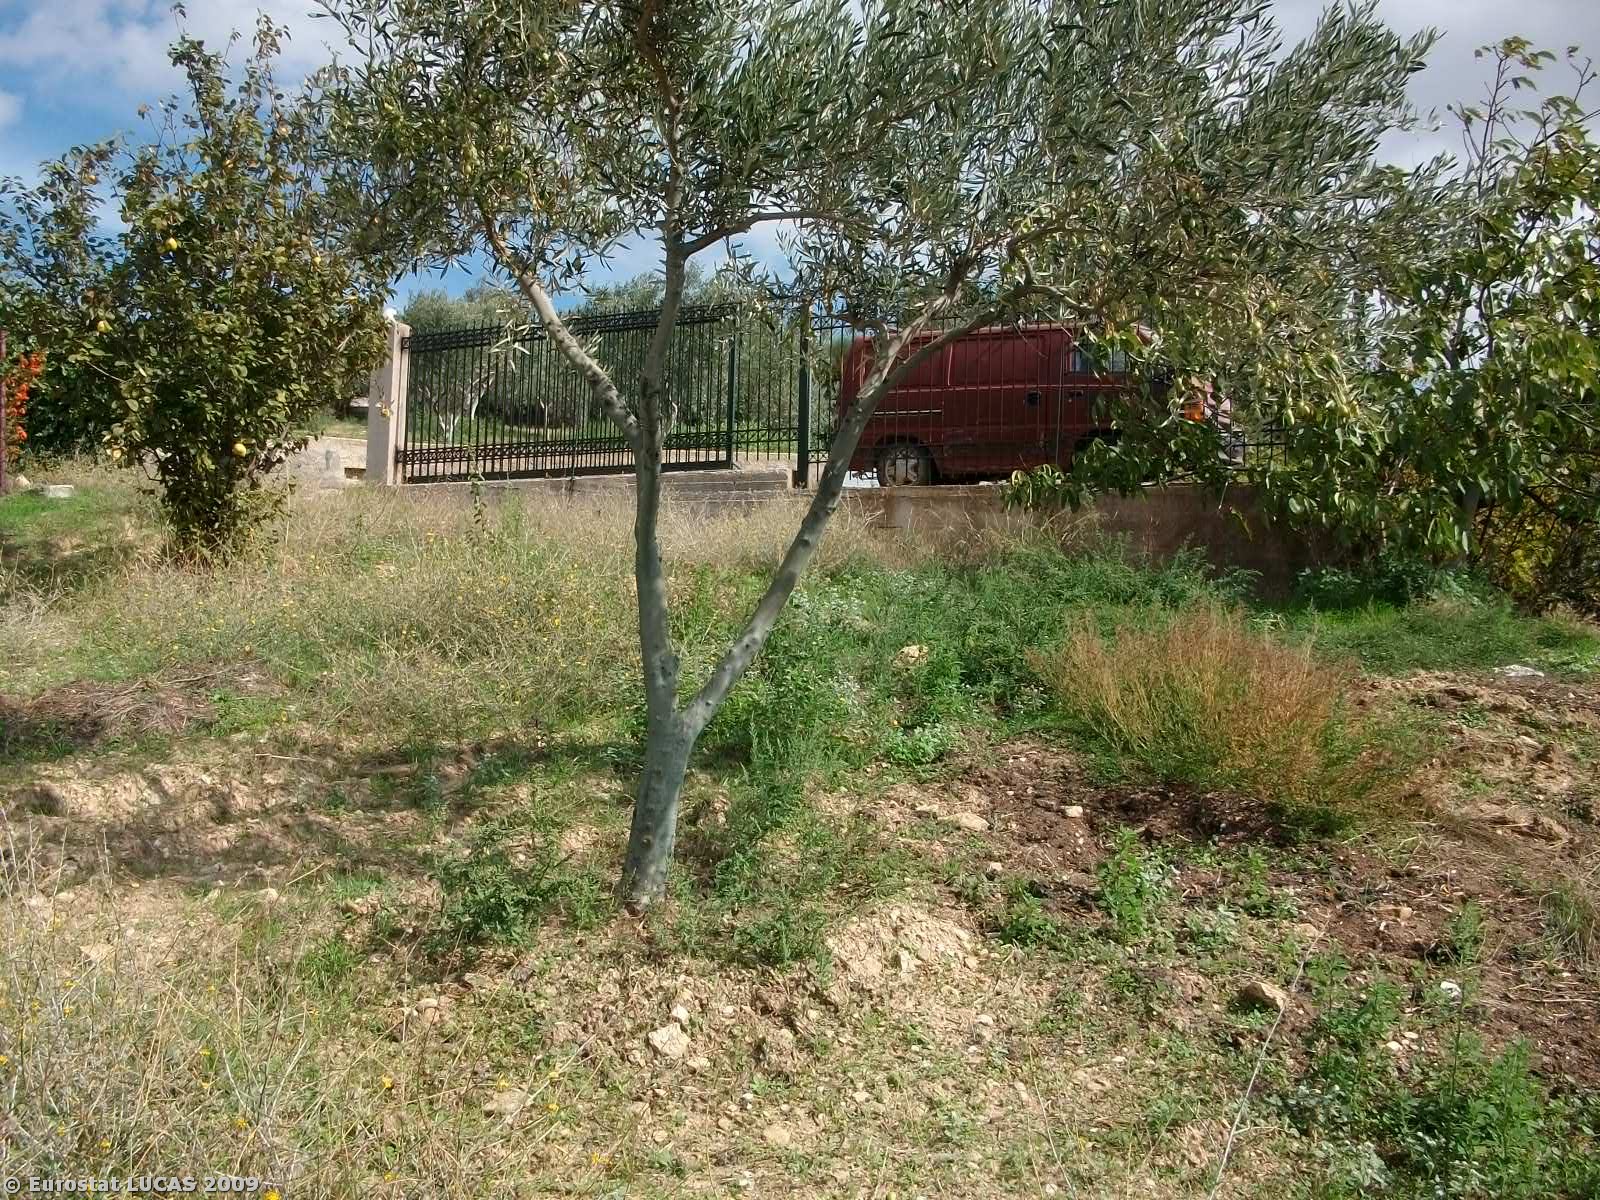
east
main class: Cropland
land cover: Olive groves
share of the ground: 25 - 50 %
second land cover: Grassland with sparse tree/shrub cover
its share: > 75 %
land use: Agriculture (excluding fallow land and kitchen gardens)
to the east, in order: Olive groves; Grassland with sparse tree/shrub cover; Paved roads, cycling and walking lanes; Fences; Olive groves; Grassland with sparse tree/shrub cover; Olive groves; Grassland with sparse tree/shrub cover; Fences; Coniferous woodland; Grassland with sparse tree/shrub cover; Coniferous woodland; Grassland without tree/shrub cover; Coniferous woodland
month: September
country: GR
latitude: 38.1364
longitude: 23.8924
